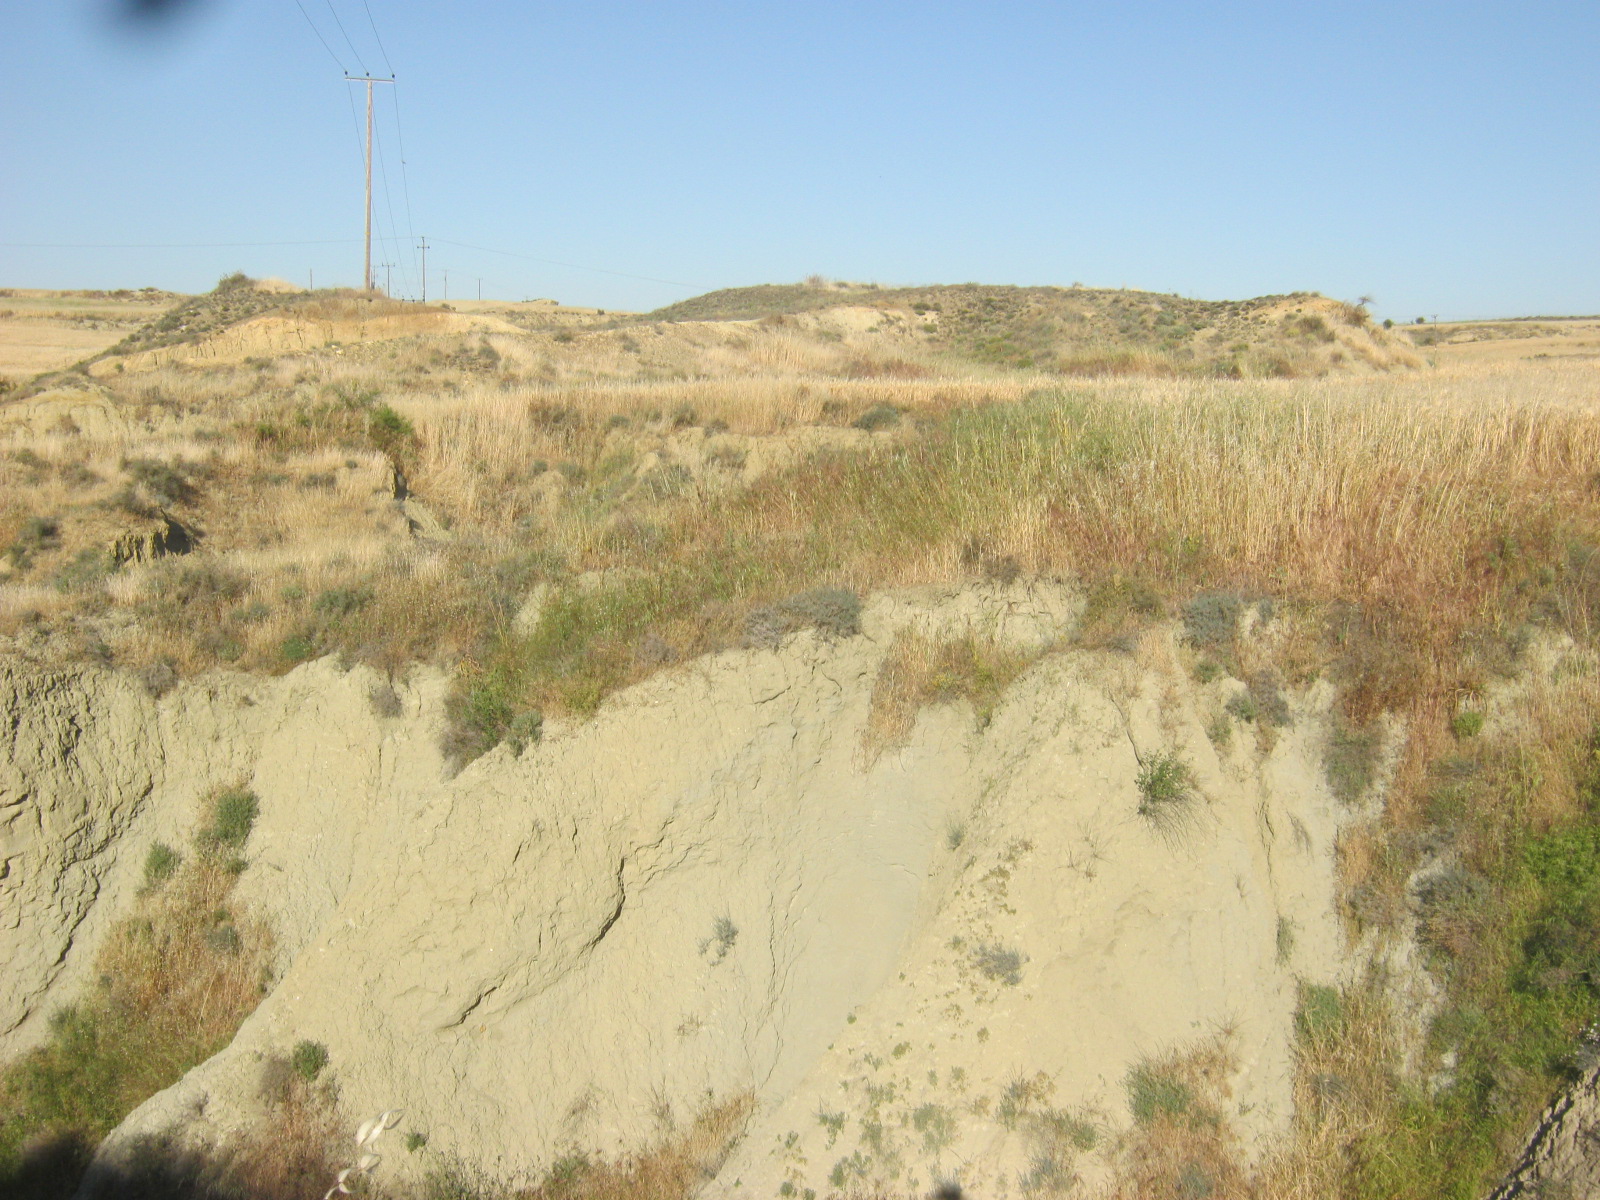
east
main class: Grassland
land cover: Spontaneously vegetated surfaces
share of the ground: > 75 %
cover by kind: herbaceous plants 95 %, unconsolidated bare surface 5 %
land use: Semi-natural and natural areas not in use
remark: Temporary dry
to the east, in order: Spontaneously vegetated surfaces; Inland fresh running water; Spontaneously vegetated surfaces; Common wheat; Shrubland without tree cover; Grassland without tree/shrub cover; Shrubland without tree cover; Common wheat; Paved roads, cycling and walking lanes; Grassland with sparse tree/shrub cover; Grassland without tree/shrub cover
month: May
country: CY
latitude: 35.0563
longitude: 33.2204
